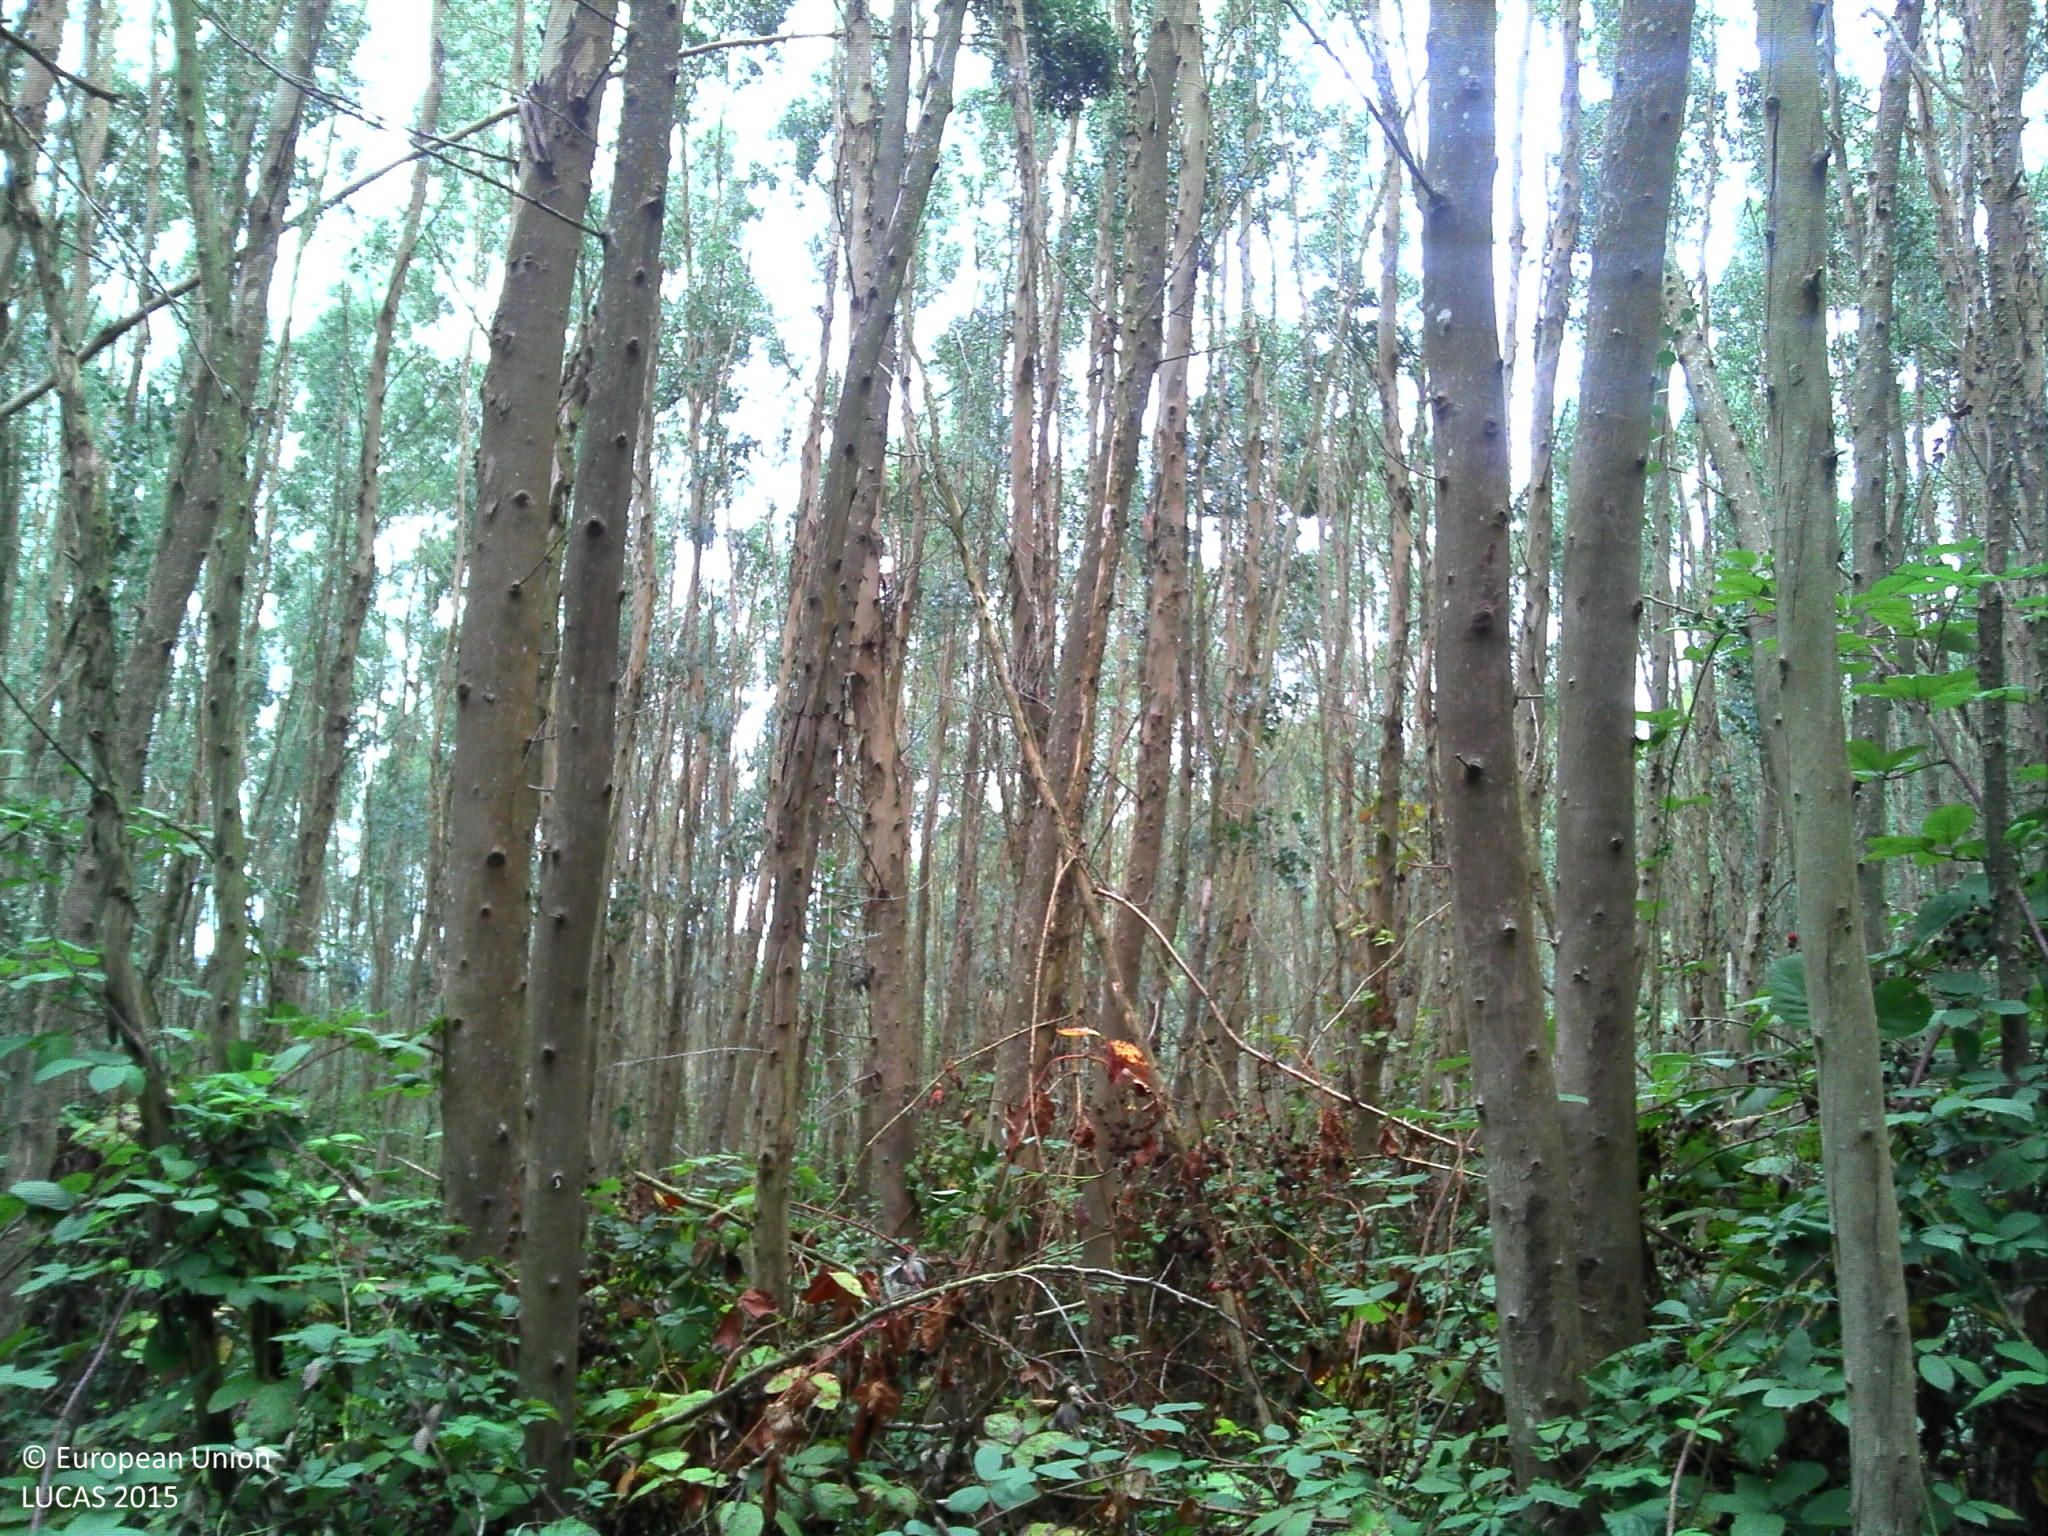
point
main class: Woodland
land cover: Broadleaved woodland
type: exotic forest
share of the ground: 50 - 75 %
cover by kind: broadleaved forest trees 60 %, shrubs 30 %, herbaceous plants 5 %, lichens and mosses 5 %
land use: Forestry
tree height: > 5 m
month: September
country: FR
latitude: 43.3813
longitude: -0.4878
